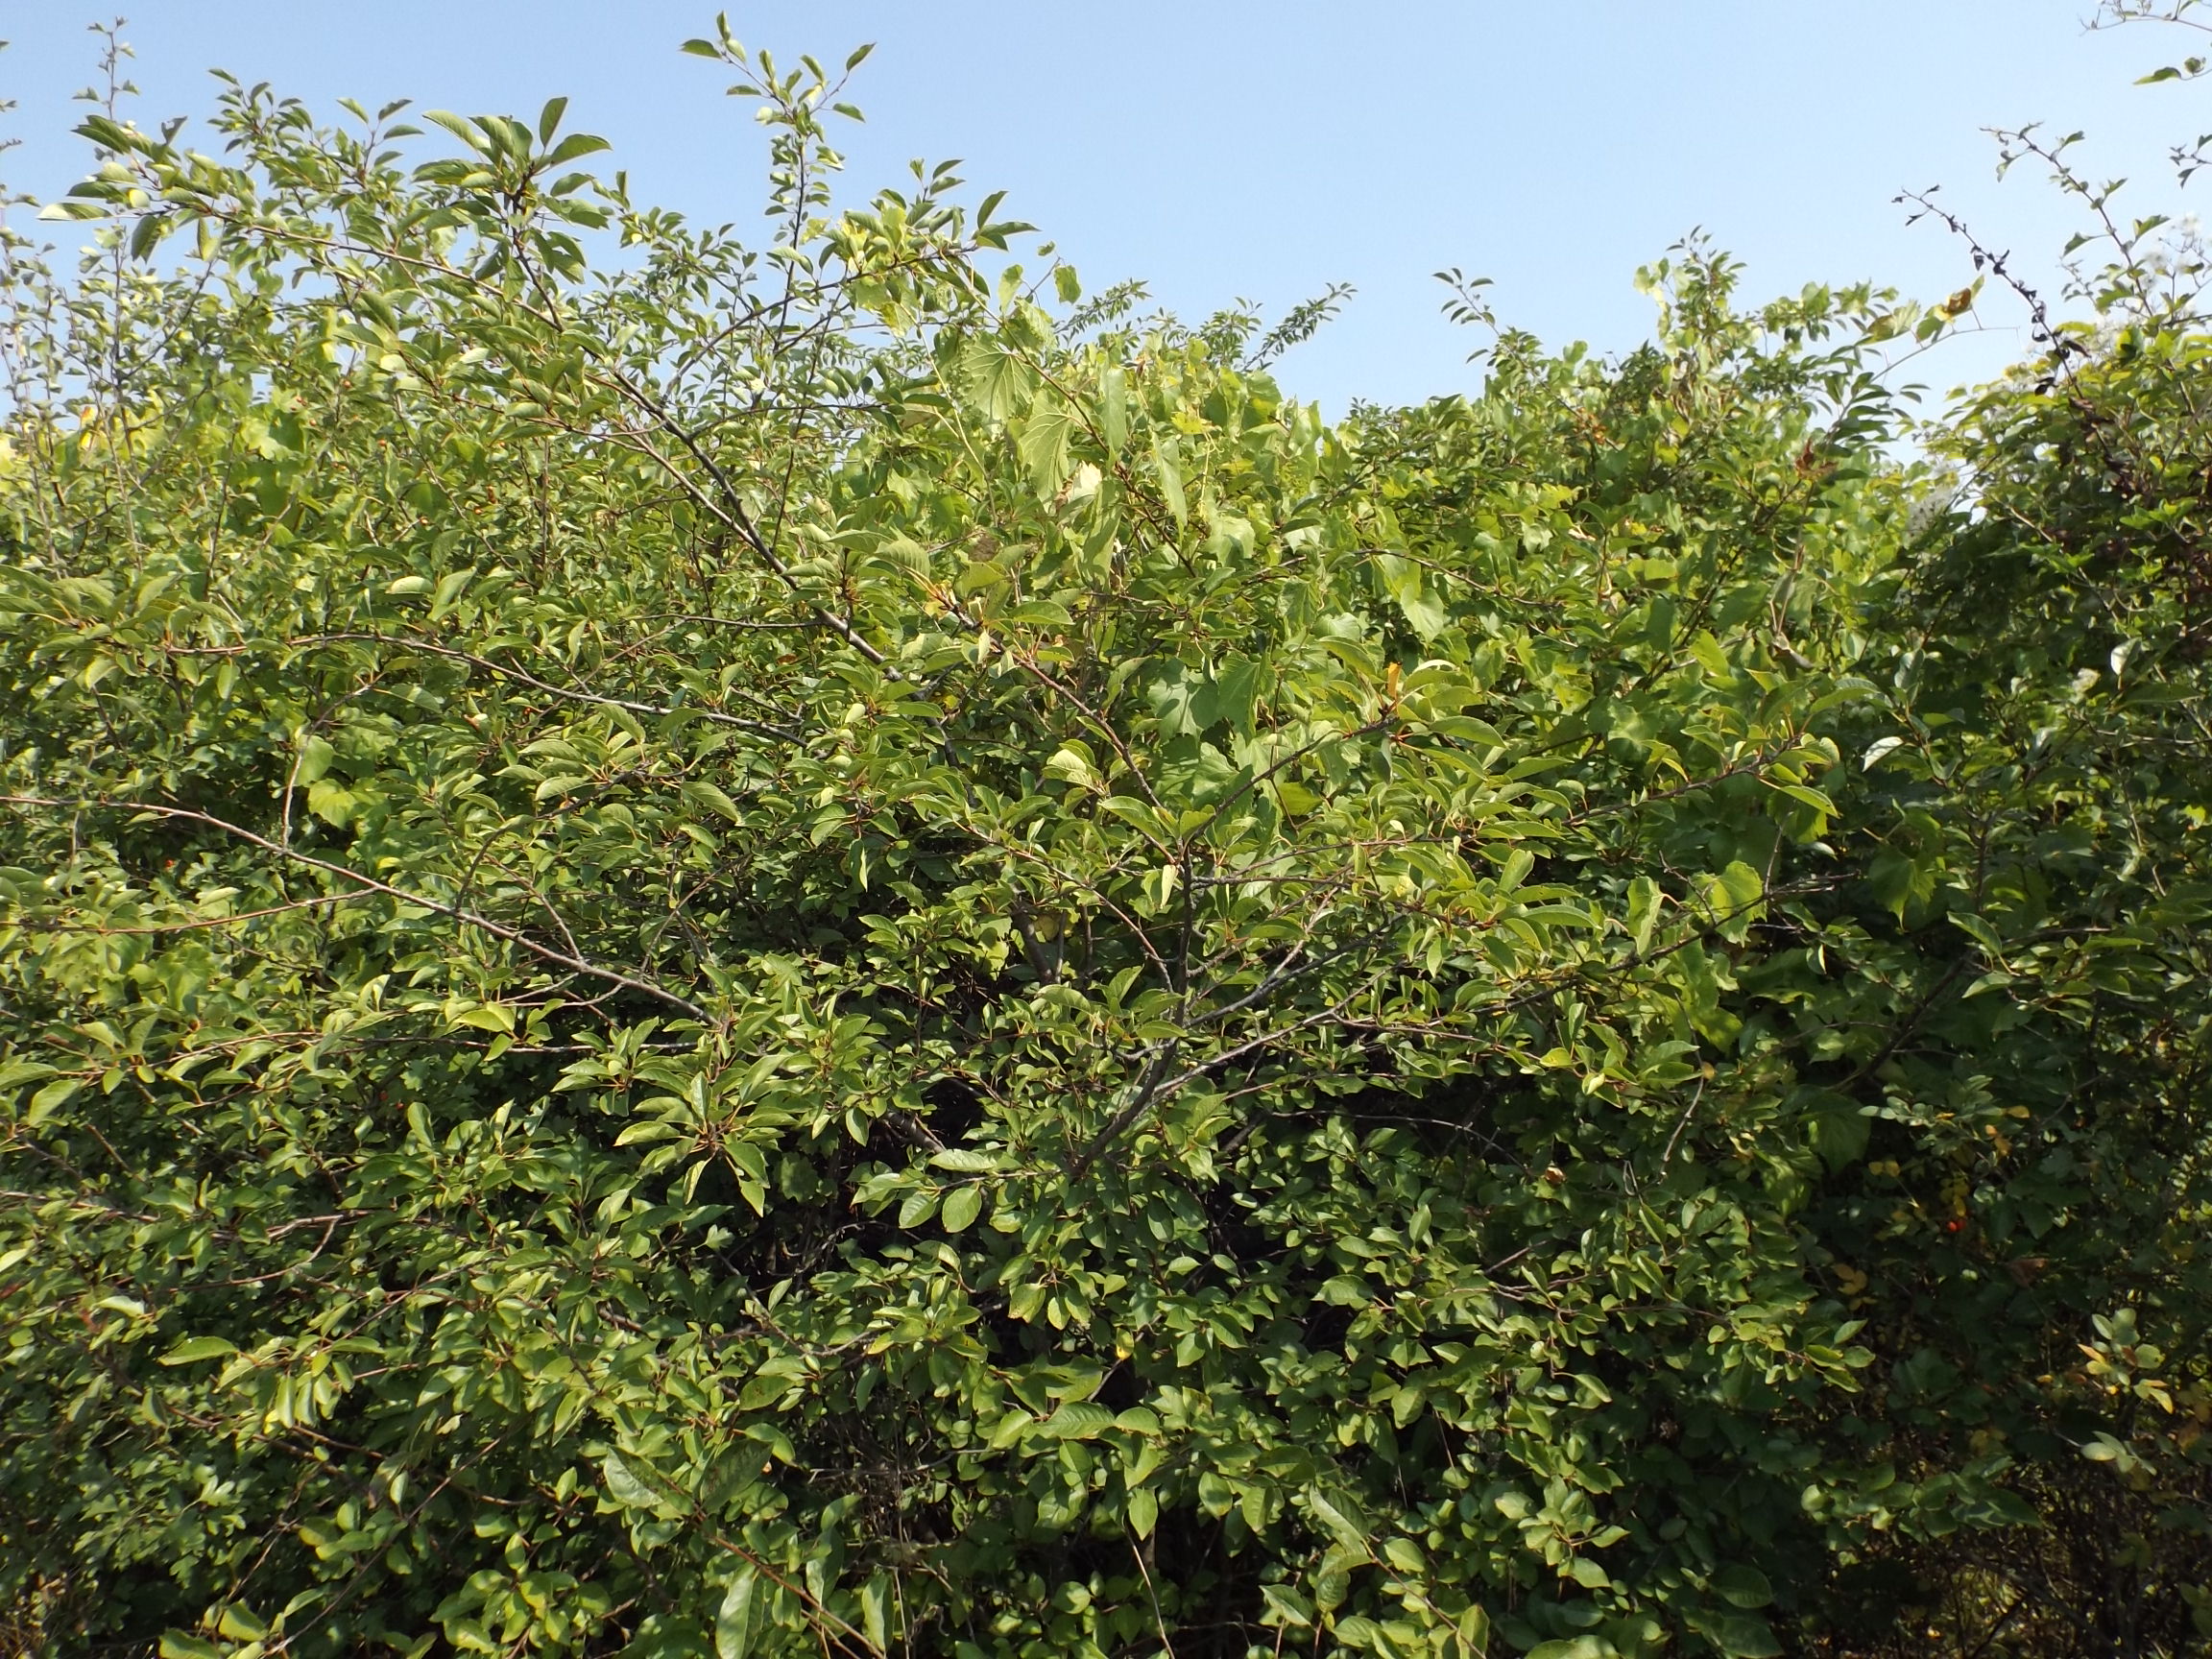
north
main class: Shrubland
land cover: Shrubland with sparse tree cover
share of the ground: > 75 %
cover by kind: shrubs 75 %, herbaceous plants 20 %, broadleaved forest trees 5 %
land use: Semi-natural and natural areas not in use
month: August
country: BG
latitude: 43.2164
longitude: 27.2942
